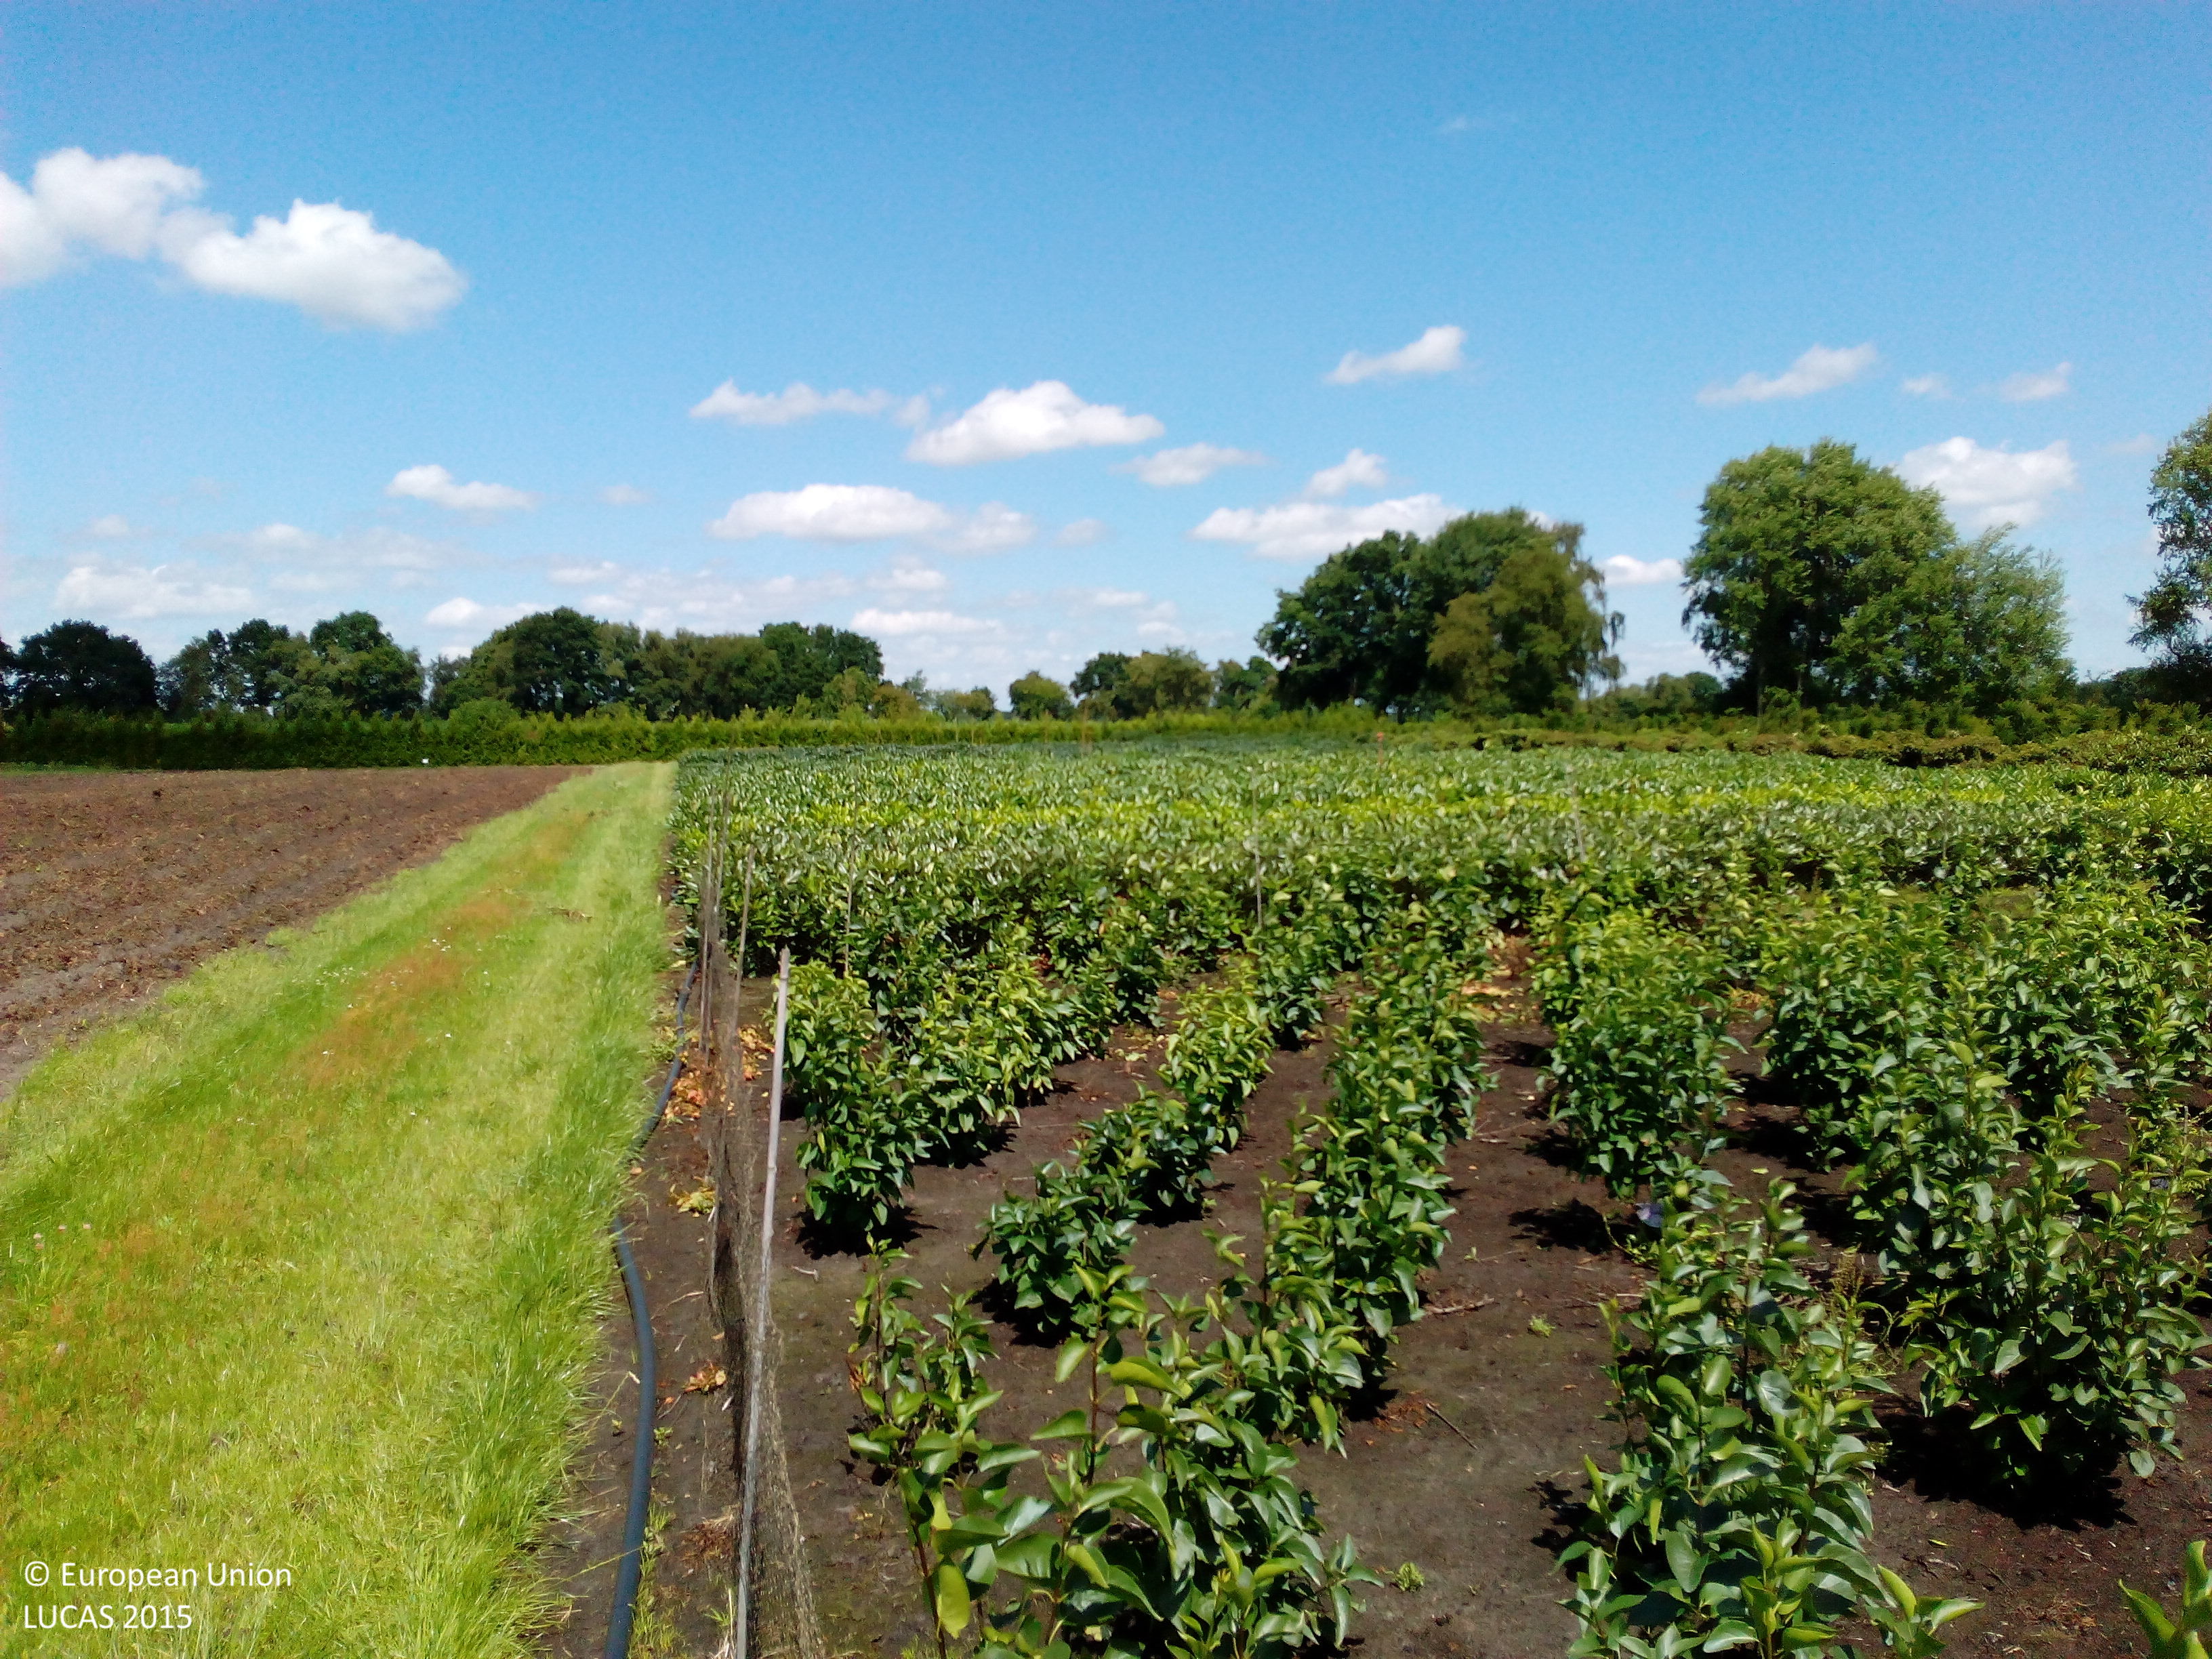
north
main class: Cropland
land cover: Nurseries
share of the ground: > 75 %
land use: Agriculture (excluding fallow land and kitchen gardens)
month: July
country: DE
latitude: 53.1684
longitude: 7.9213
